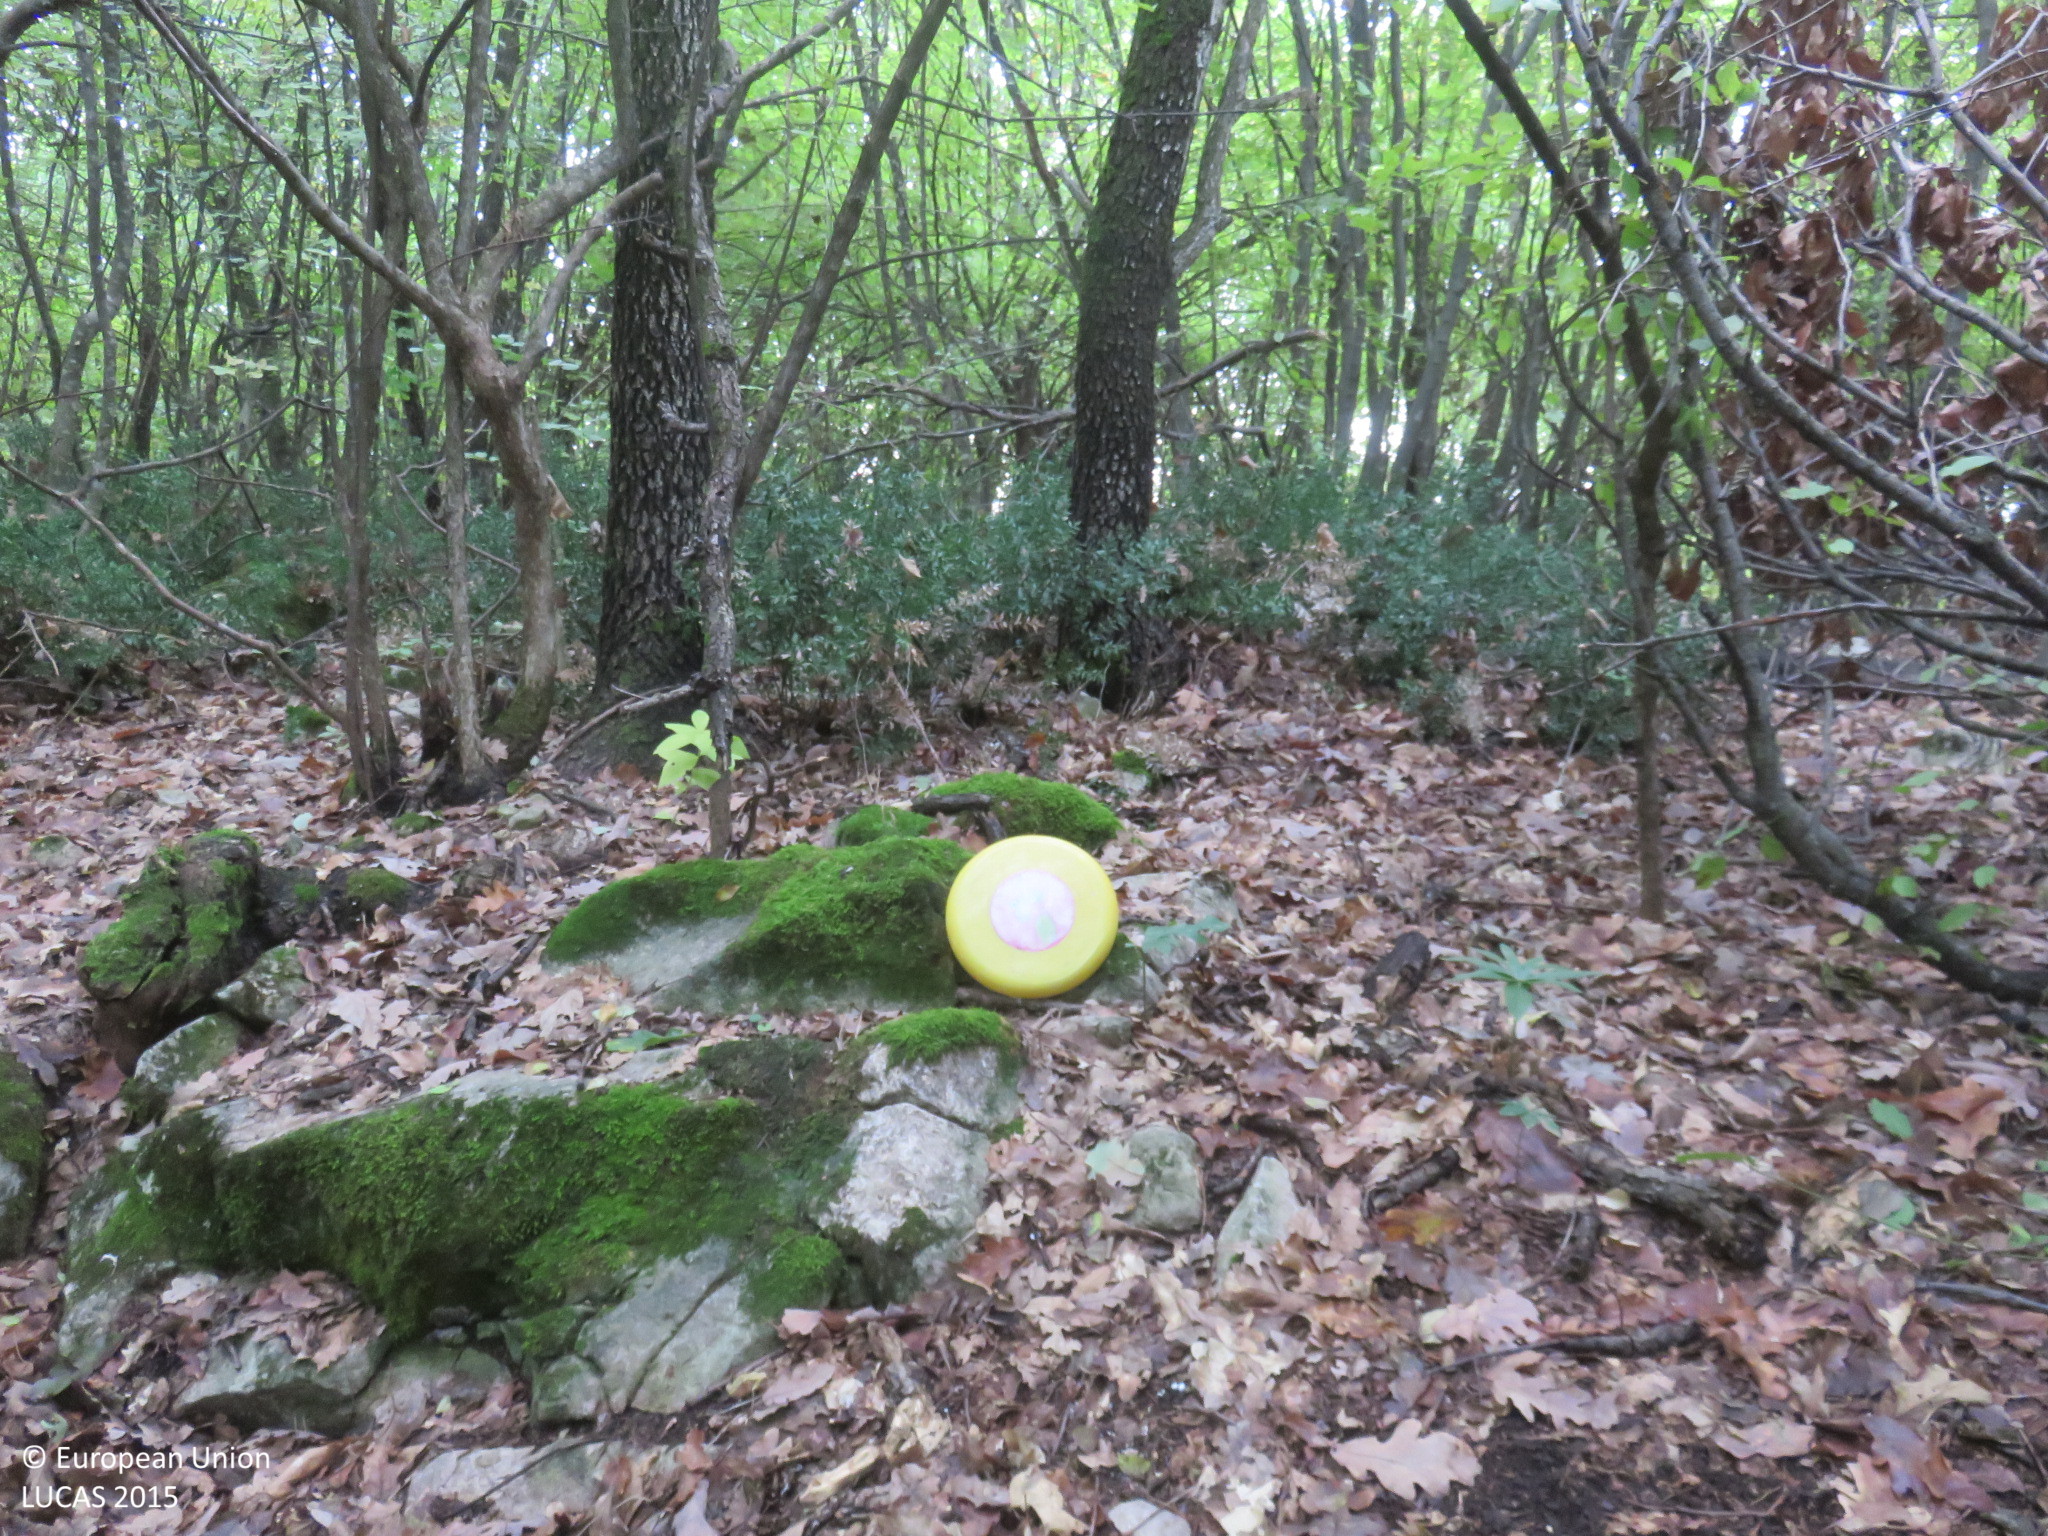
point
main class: Woodland
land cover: Broadleaved woodland
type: mesophytic deciduous forest
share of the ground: > 75 %
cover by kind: broadleaved forest trees 85 %, unconsolidated bare surface 10 %, herbaceous plants 5 %
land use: Forestry
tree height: > 5 m
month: October
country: BG
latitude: 42.9793
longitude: 25.1141
